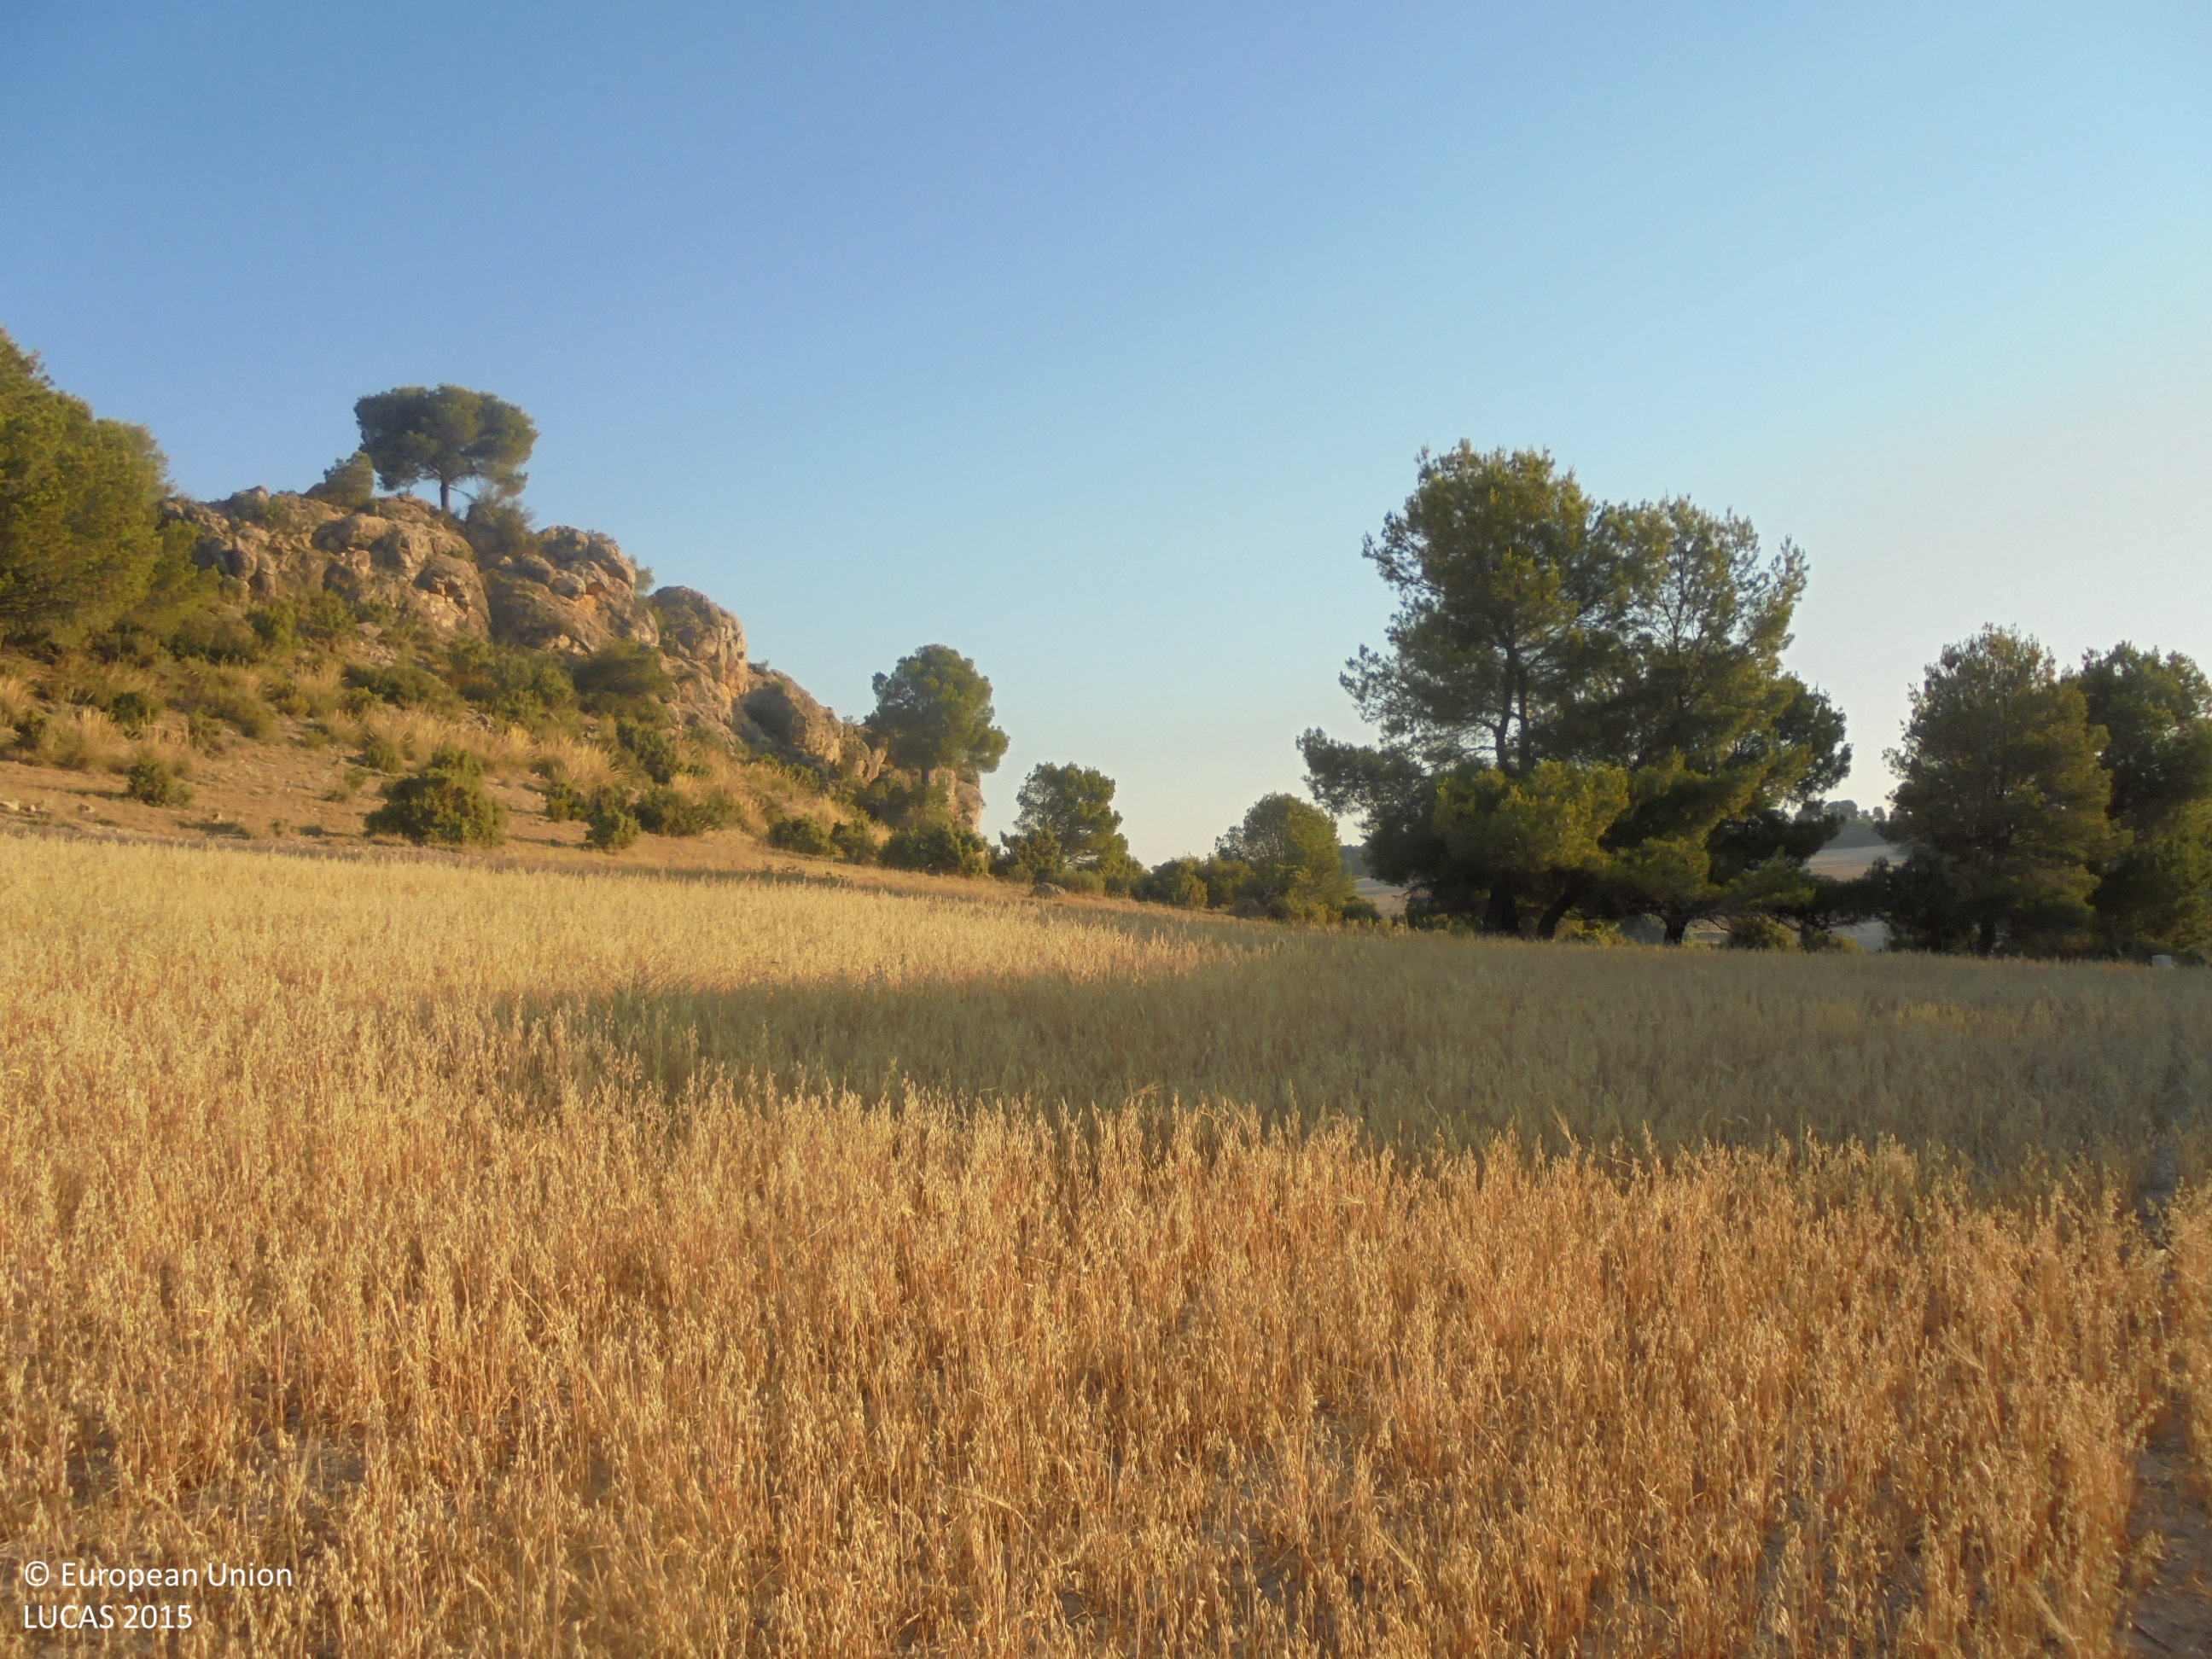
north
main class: Cropland
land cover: Oats
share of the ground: 25 - 50 %
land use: Agriculture (excluding fallow land and kitchen gardens)
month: July
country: ES
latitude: 38.7332
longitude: -1.6258
